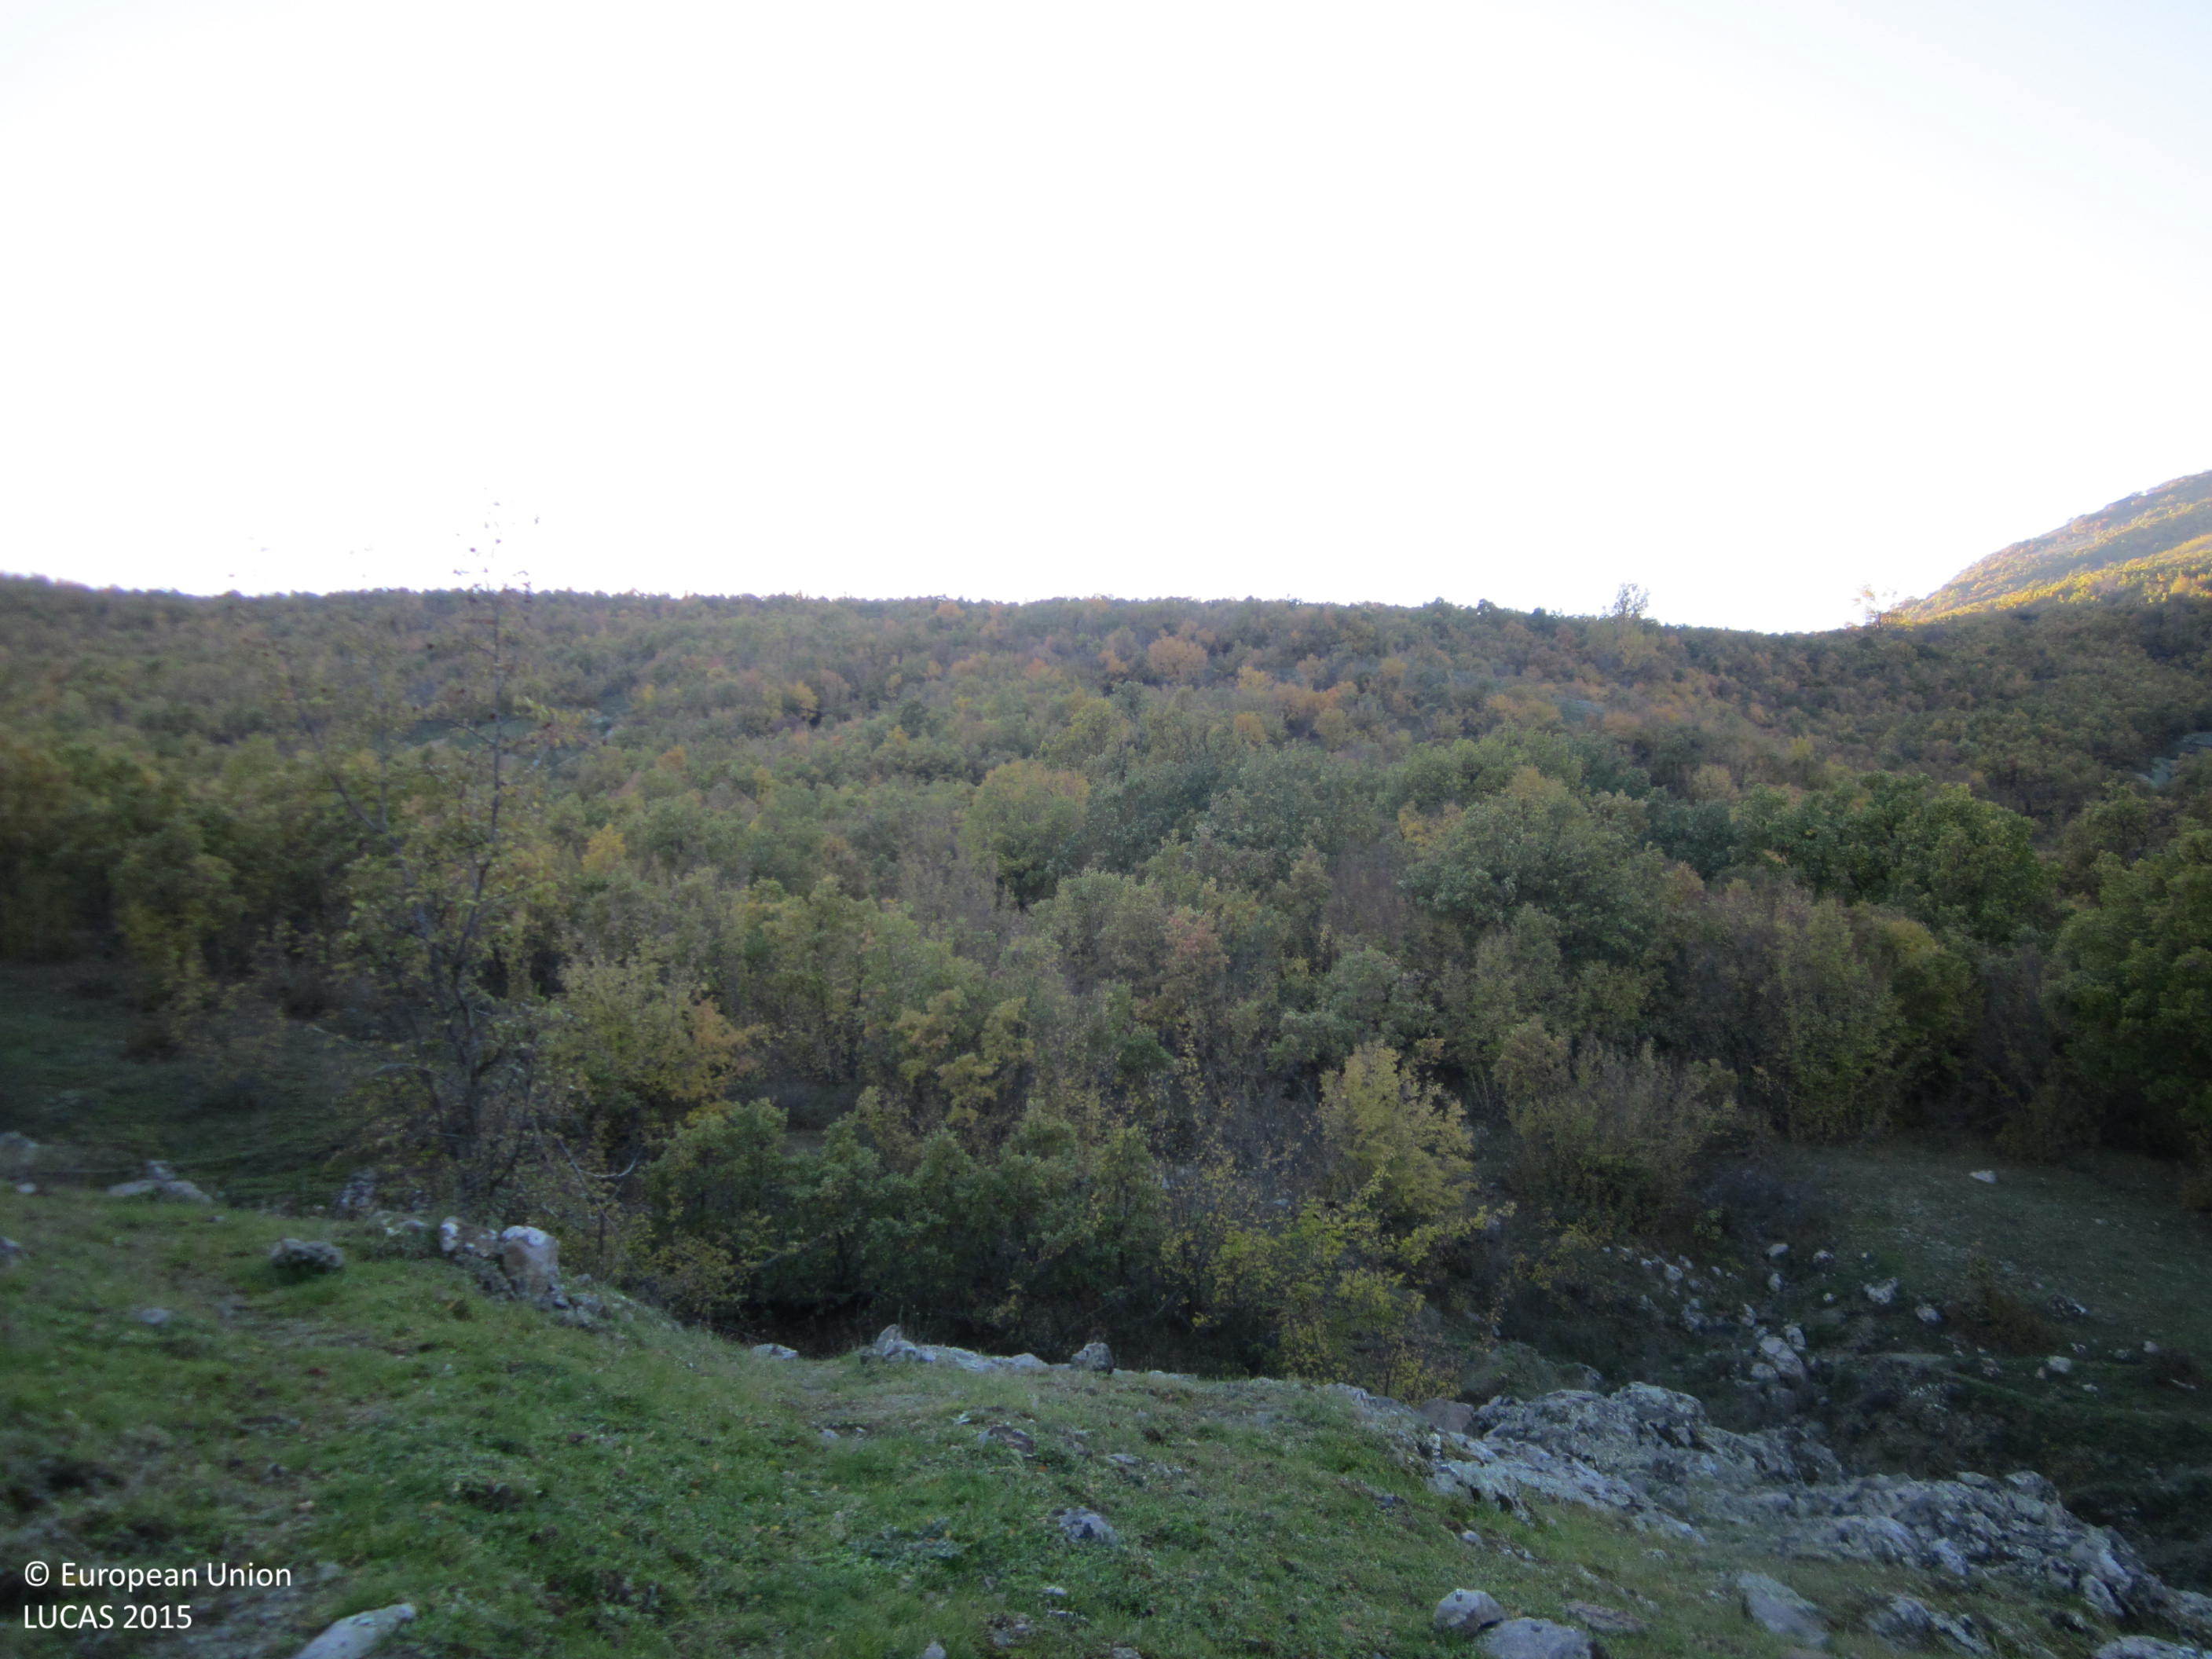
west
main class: Shrubland
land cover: Shrubland with sparse tree cover
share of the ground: 25 - 50 %
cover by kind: herbaceous plants 45 %, shrubs 40 %, unconsolidated bare surface 10 %, broadleaved forest trees 5 %
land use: Agriculture (excluding fallow land and kitchen gardens)
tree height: < 5 m
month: November
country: BG
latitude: 41.5770
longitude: 25.6412
